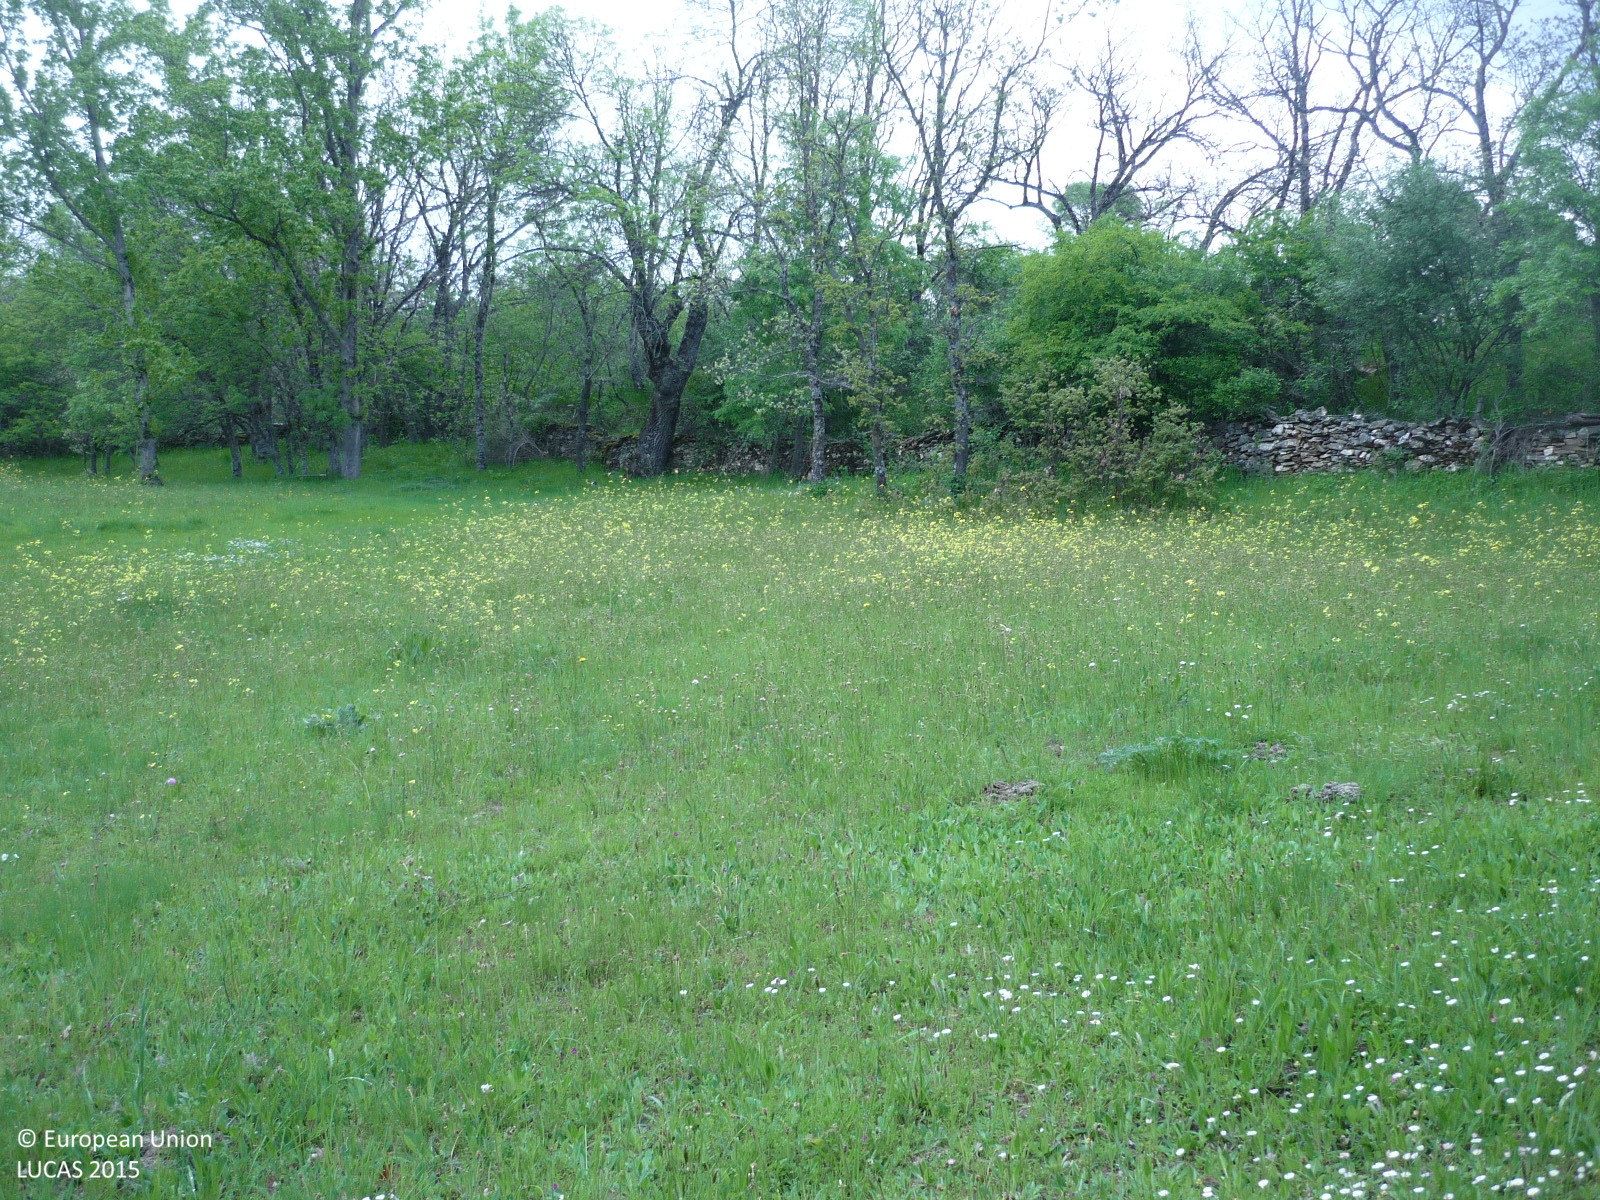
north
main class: Grassland
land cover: Grassland without tree/shrub cover
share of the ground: > 75 %
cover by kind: herbaceous plants 100 %
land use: Agriculture (excluding fallow land and kitchen gardens)
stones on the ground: < 10 %
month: May
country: ES
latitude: 41.0652
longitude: -3.5262
